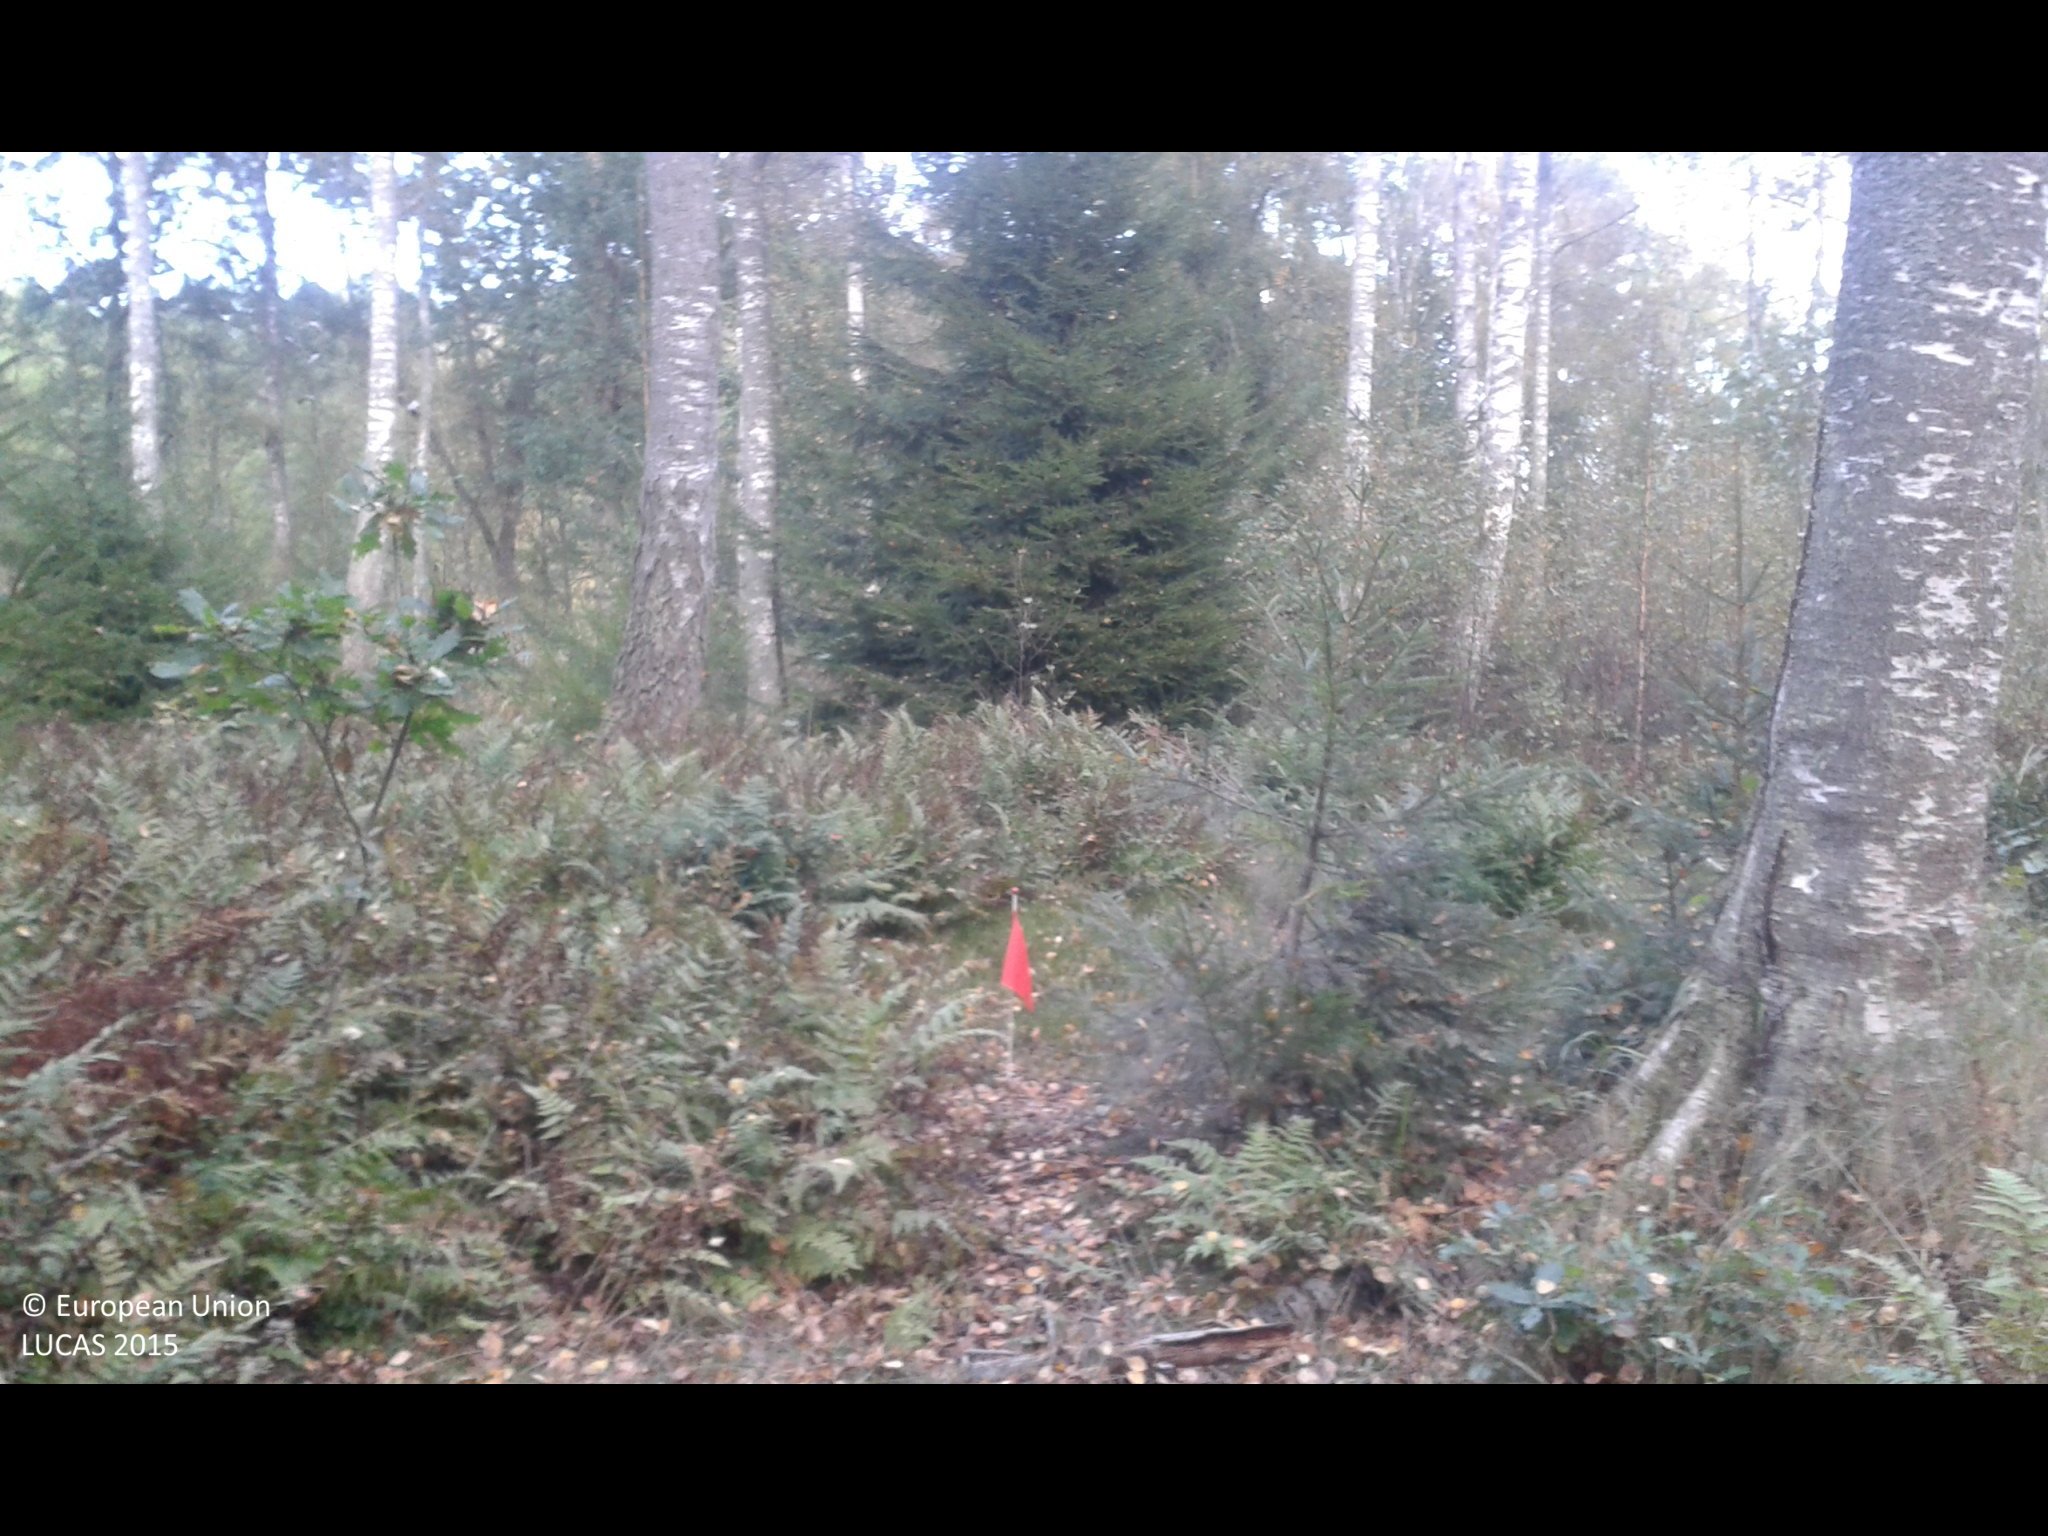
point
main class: Woodland
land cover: Spruce dominated mixed woodland
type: hemiboreal forest and nemoral coniferous forest and mixed broadleaved-coniferous forest
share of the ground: 50 - 75 %
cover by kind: broadleaved forest trees 45 %, herbaceous plants 40 %, coniferous forest trees 15 %
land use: Forestry
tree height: > 5 m
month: September
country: SE
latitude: 58.9346
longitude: 17.4513
